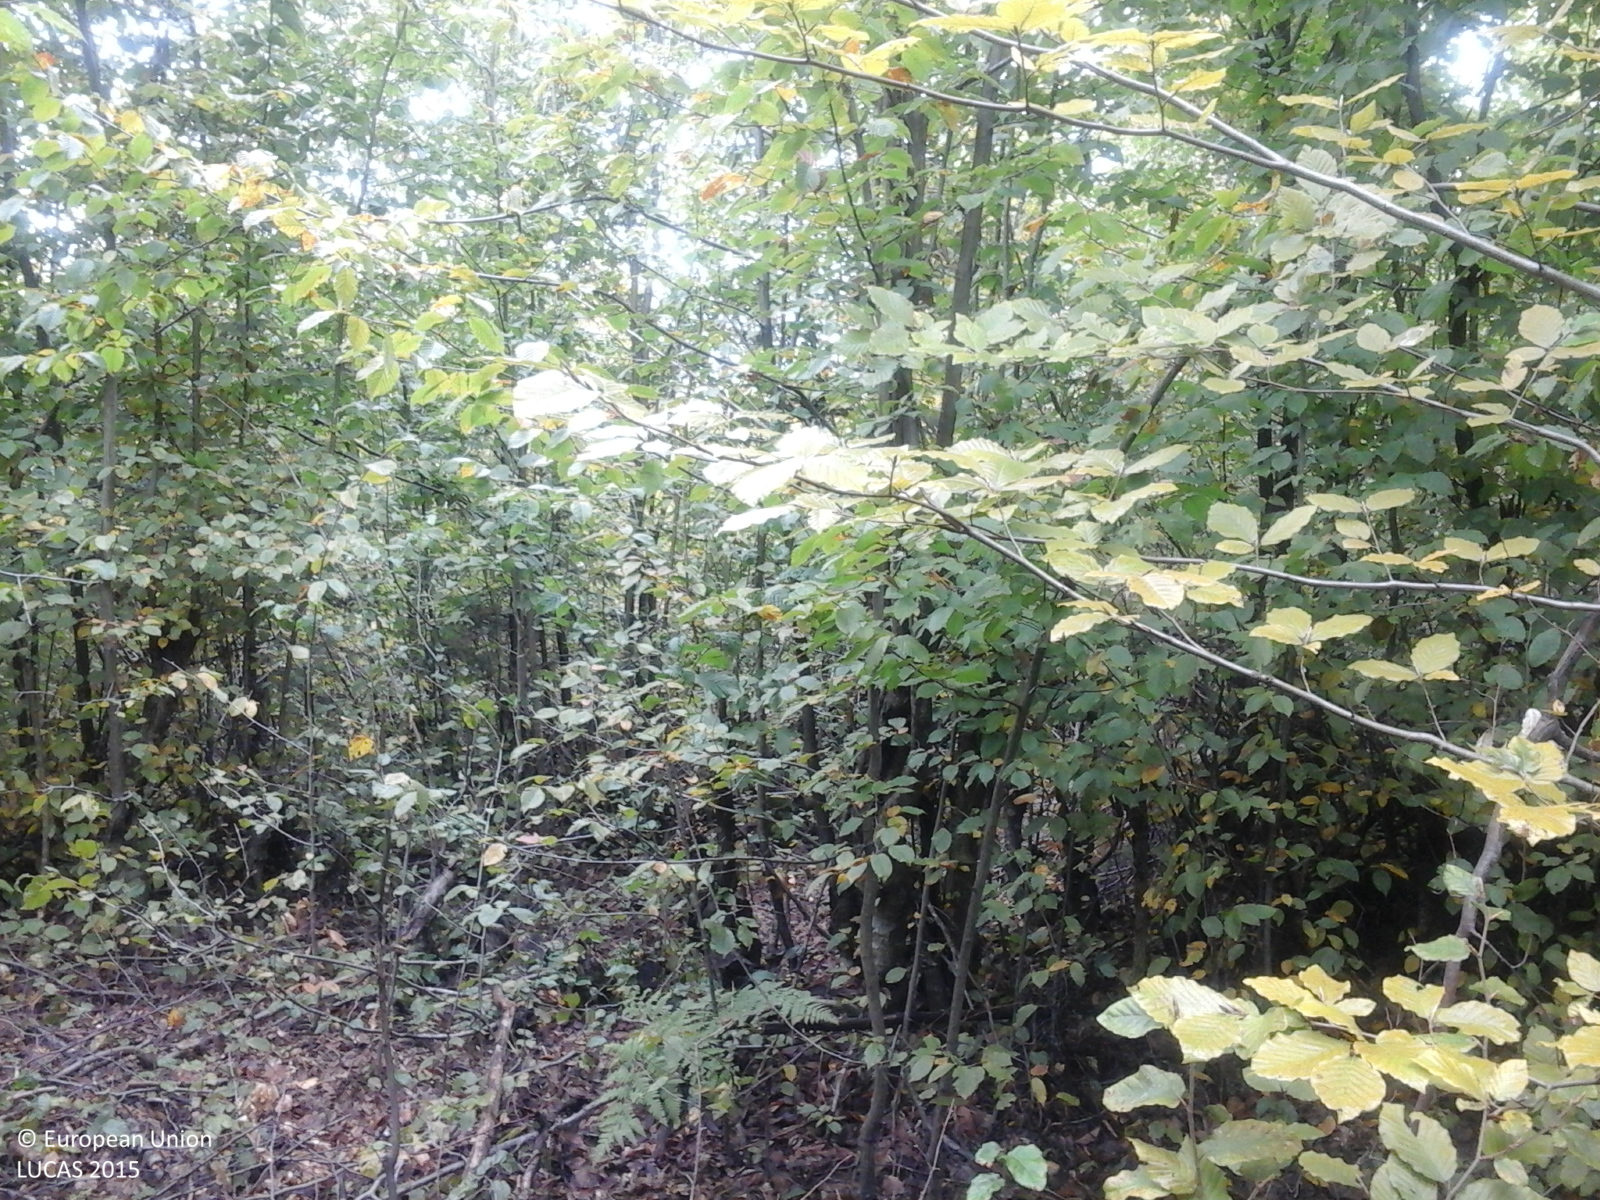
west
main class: Woodland
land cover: Broadleaved woodland
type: beech forest
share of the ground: > 75 %
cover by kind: broadleaved forest trees 100 %
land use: Forestry
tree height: > 5 m
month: October
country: RO
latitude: 45.7028
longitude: 25.0295
